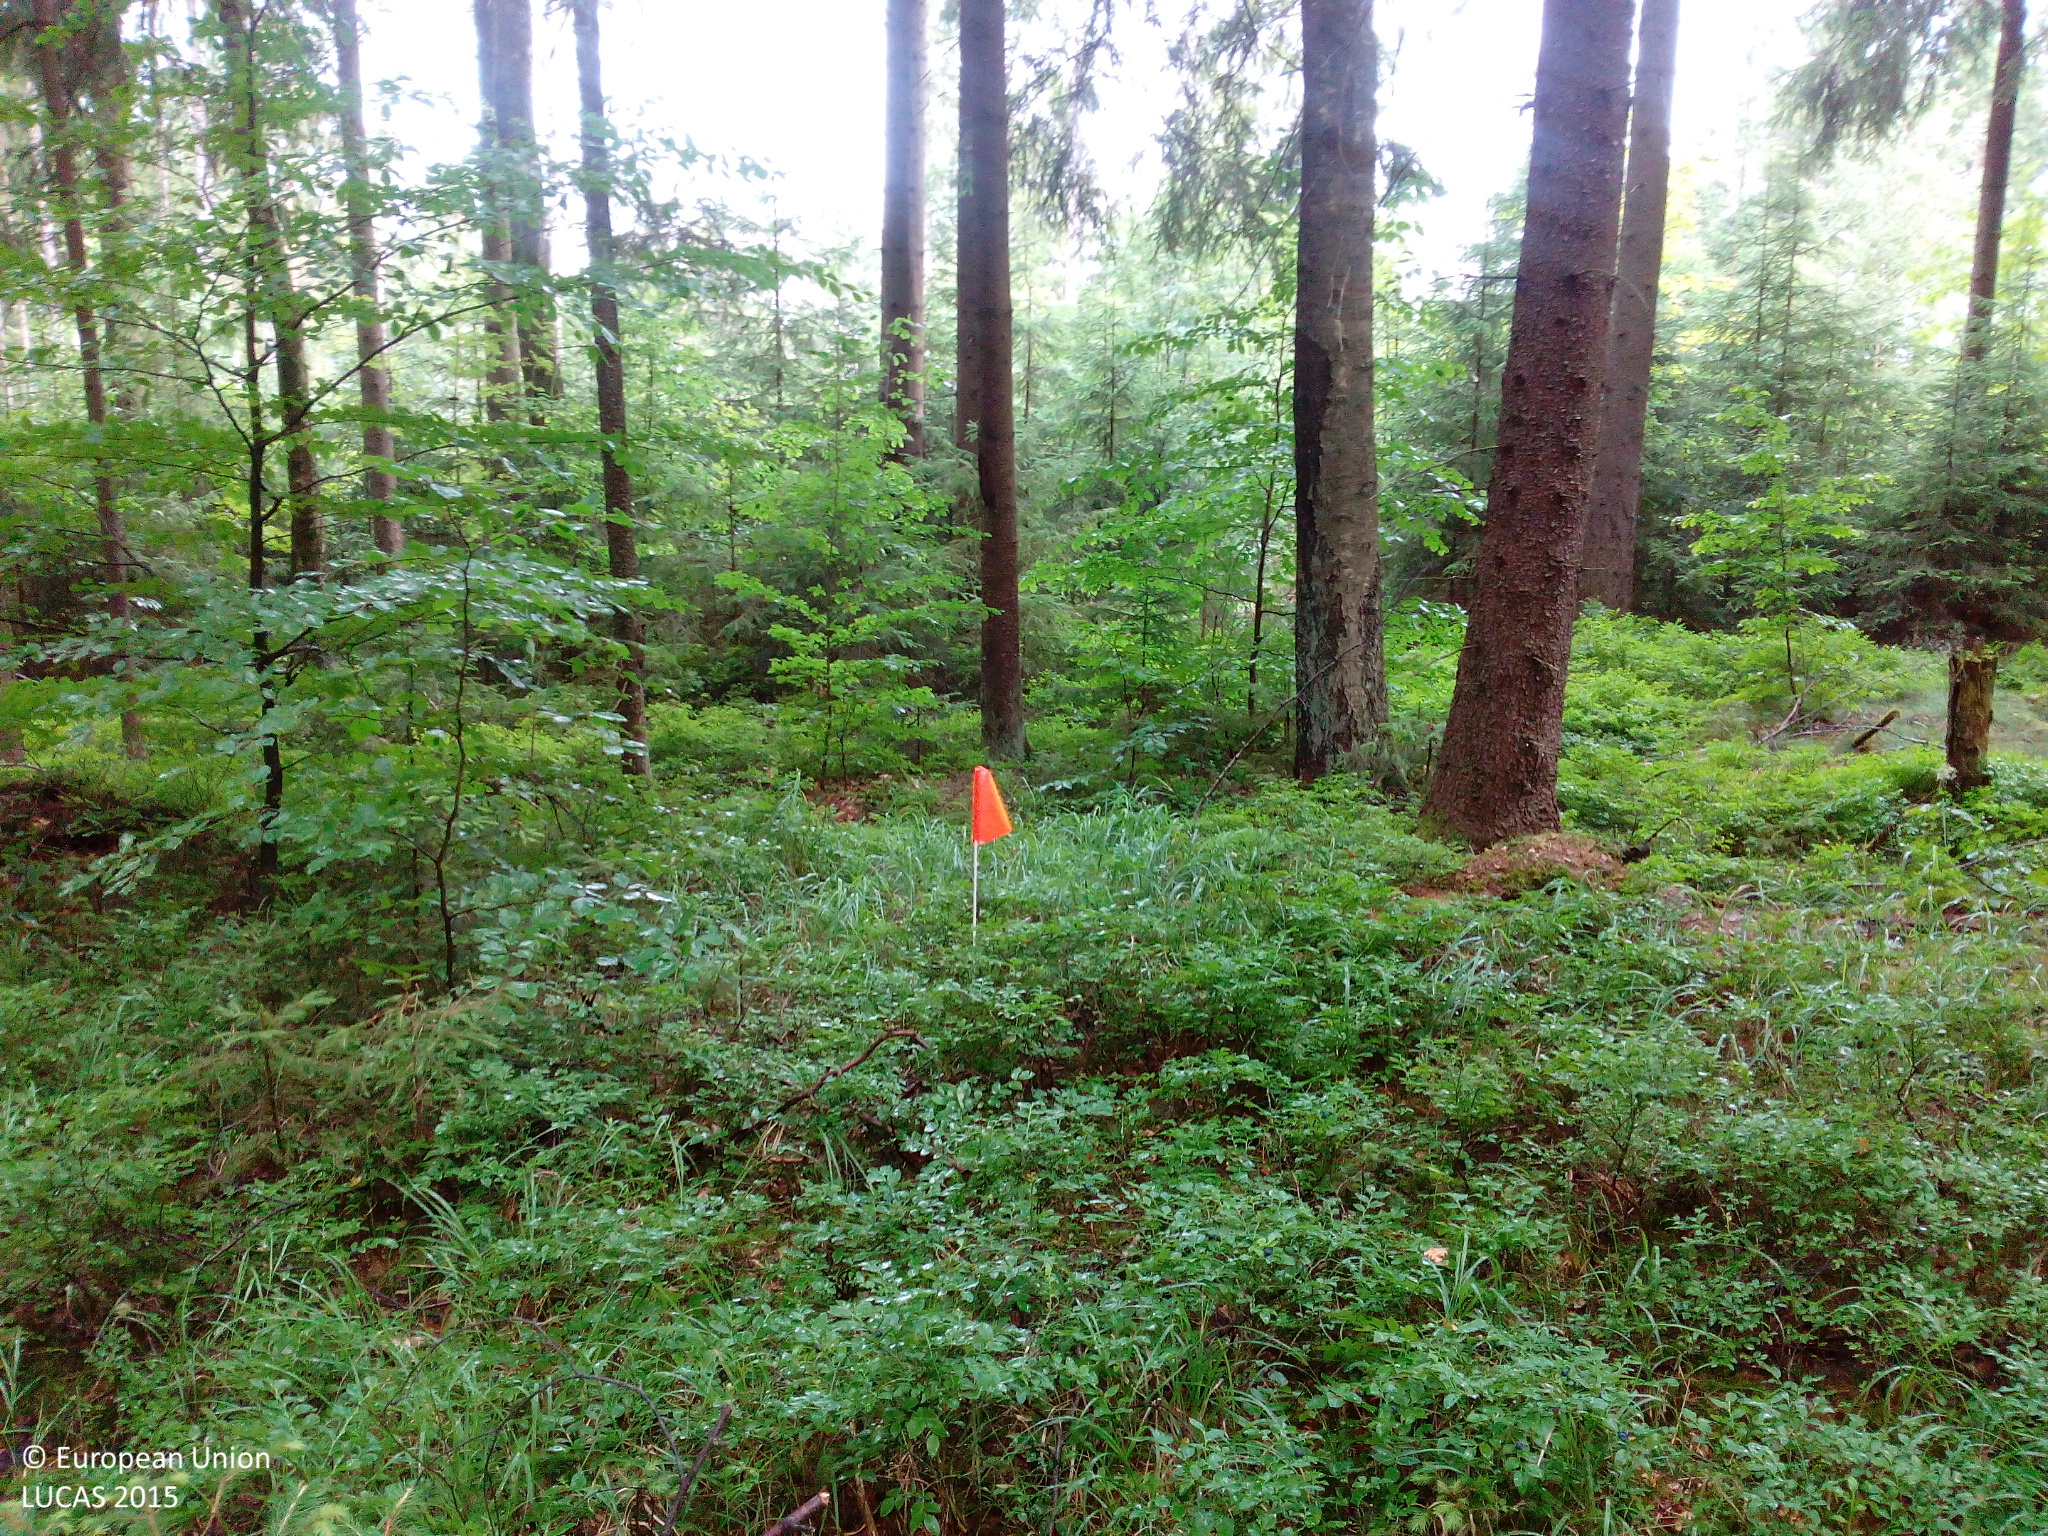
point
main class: Woodland
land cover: Spruce dominated coniferous woodland
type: hemiboreal forest and nemoral coniferous forest and mixed broadleaved-coniferous forest
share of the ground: > 75 %
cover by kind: coniferous forest trees 55 %, shrubs 20 %, broadleaved forest trees 10 %, herbaceous plants 10 %, lichens and mosses 5 %
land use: Forestry
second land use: Amenities, museums, leisure
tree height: > 5 m
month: July
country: DE
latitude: 49.6727
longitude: 12.4246
